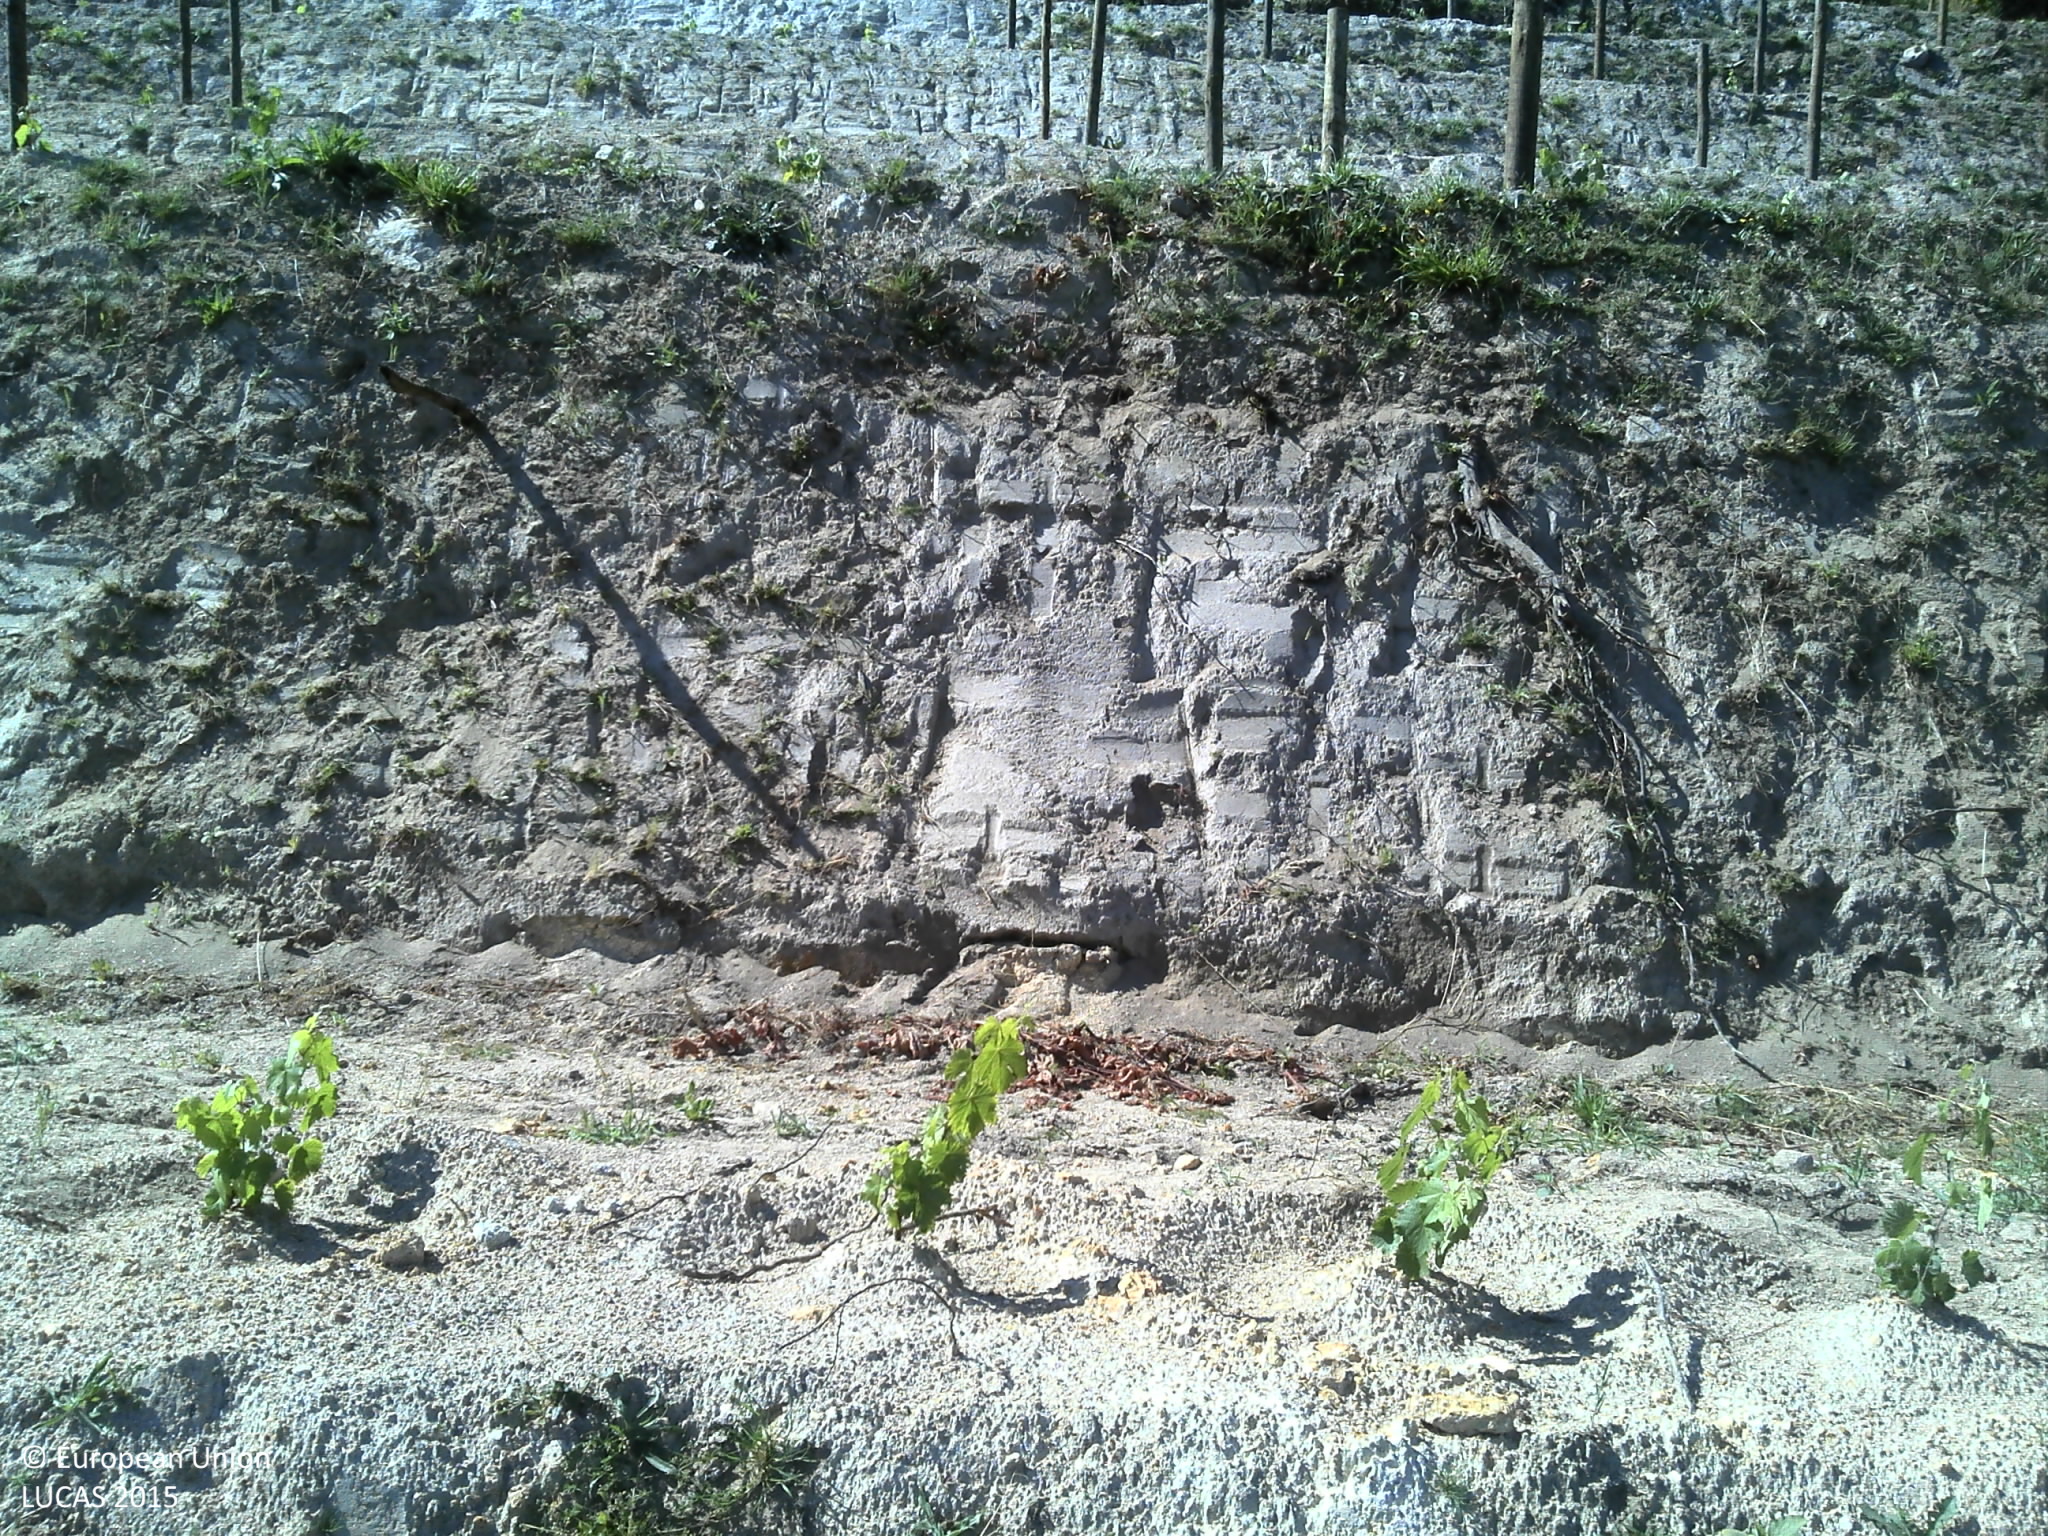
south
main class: Cropland
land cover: Vineyards
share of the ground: < 10 %
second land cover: Grassland without tree/shrub cover
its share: 25 - 50 %
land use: Agriculture (excluding fallow land and kitchen gardens)
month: July
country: PT
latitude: 41.4605
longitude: -7.8427
